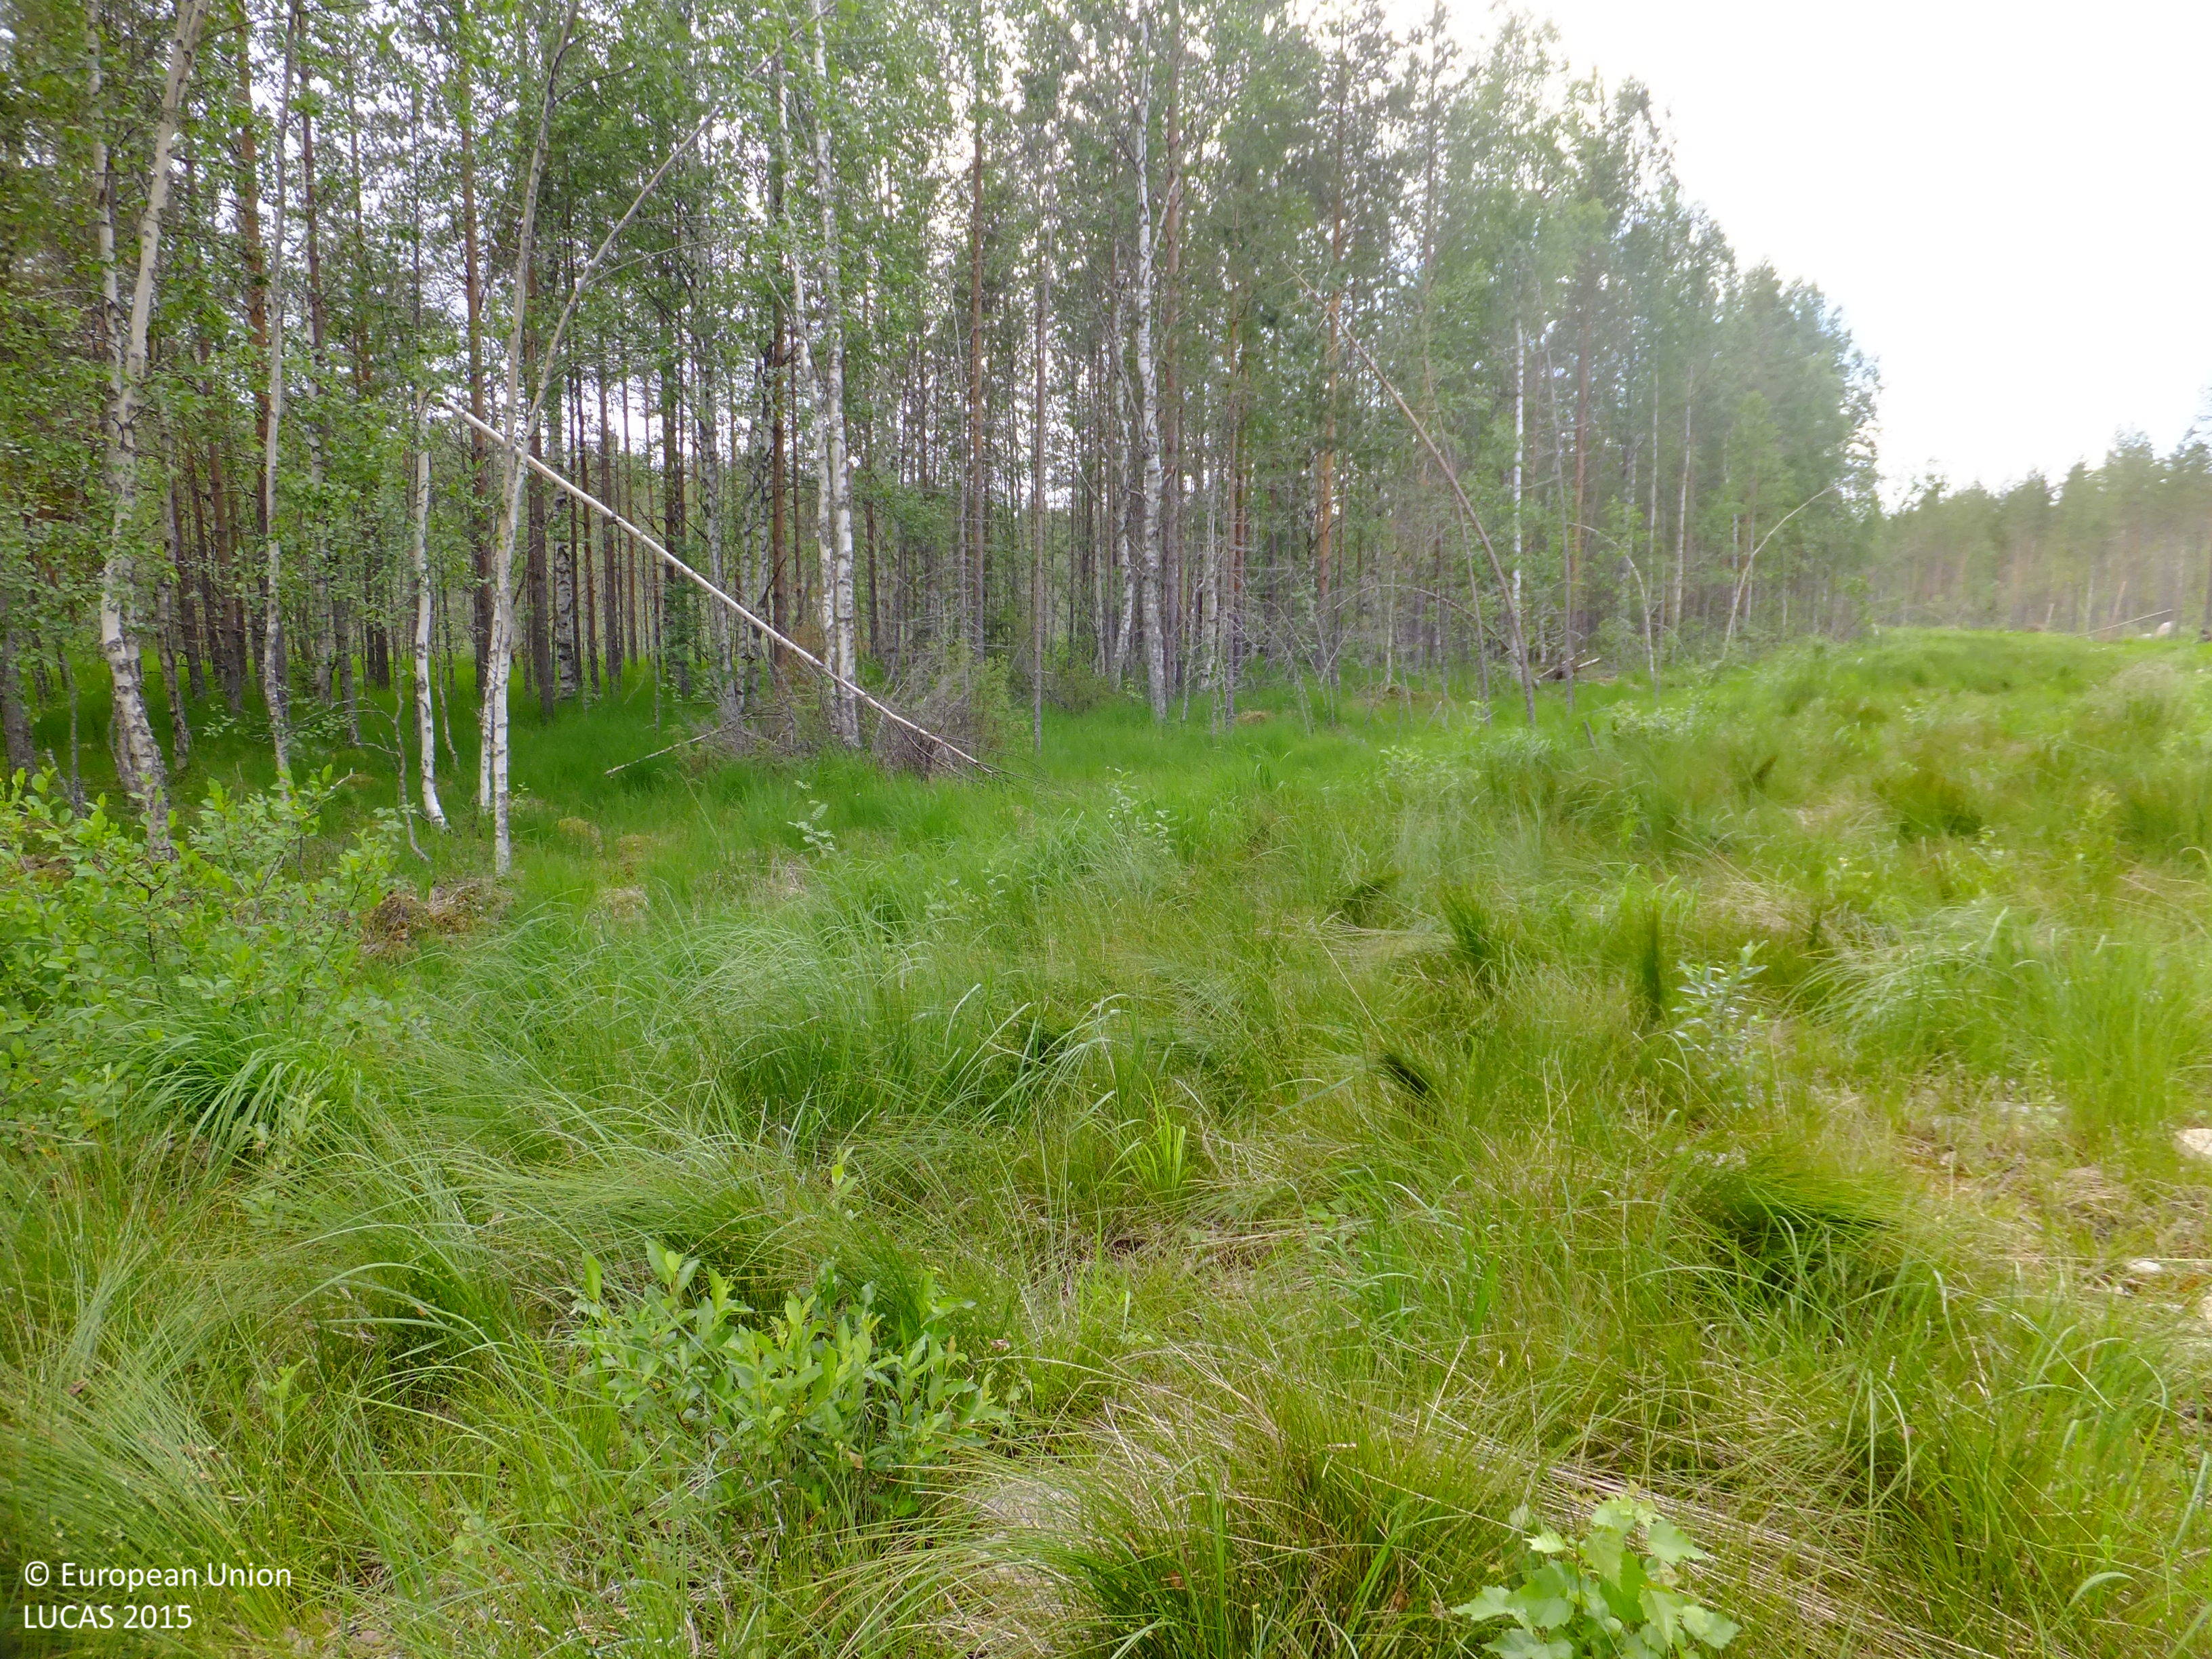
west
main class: Grassland
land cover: Grassland without tree/shrub cover
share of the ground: > 75 %
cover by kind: herbaceous plants 75 %, lichens and mosses 10 %, shrubs 5 %, consolidated bare surface 5 %, unconsolidated bare surface 5 %
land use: Abandoned areas
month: July
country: FI
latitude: 63.5289
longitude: 24.4561
